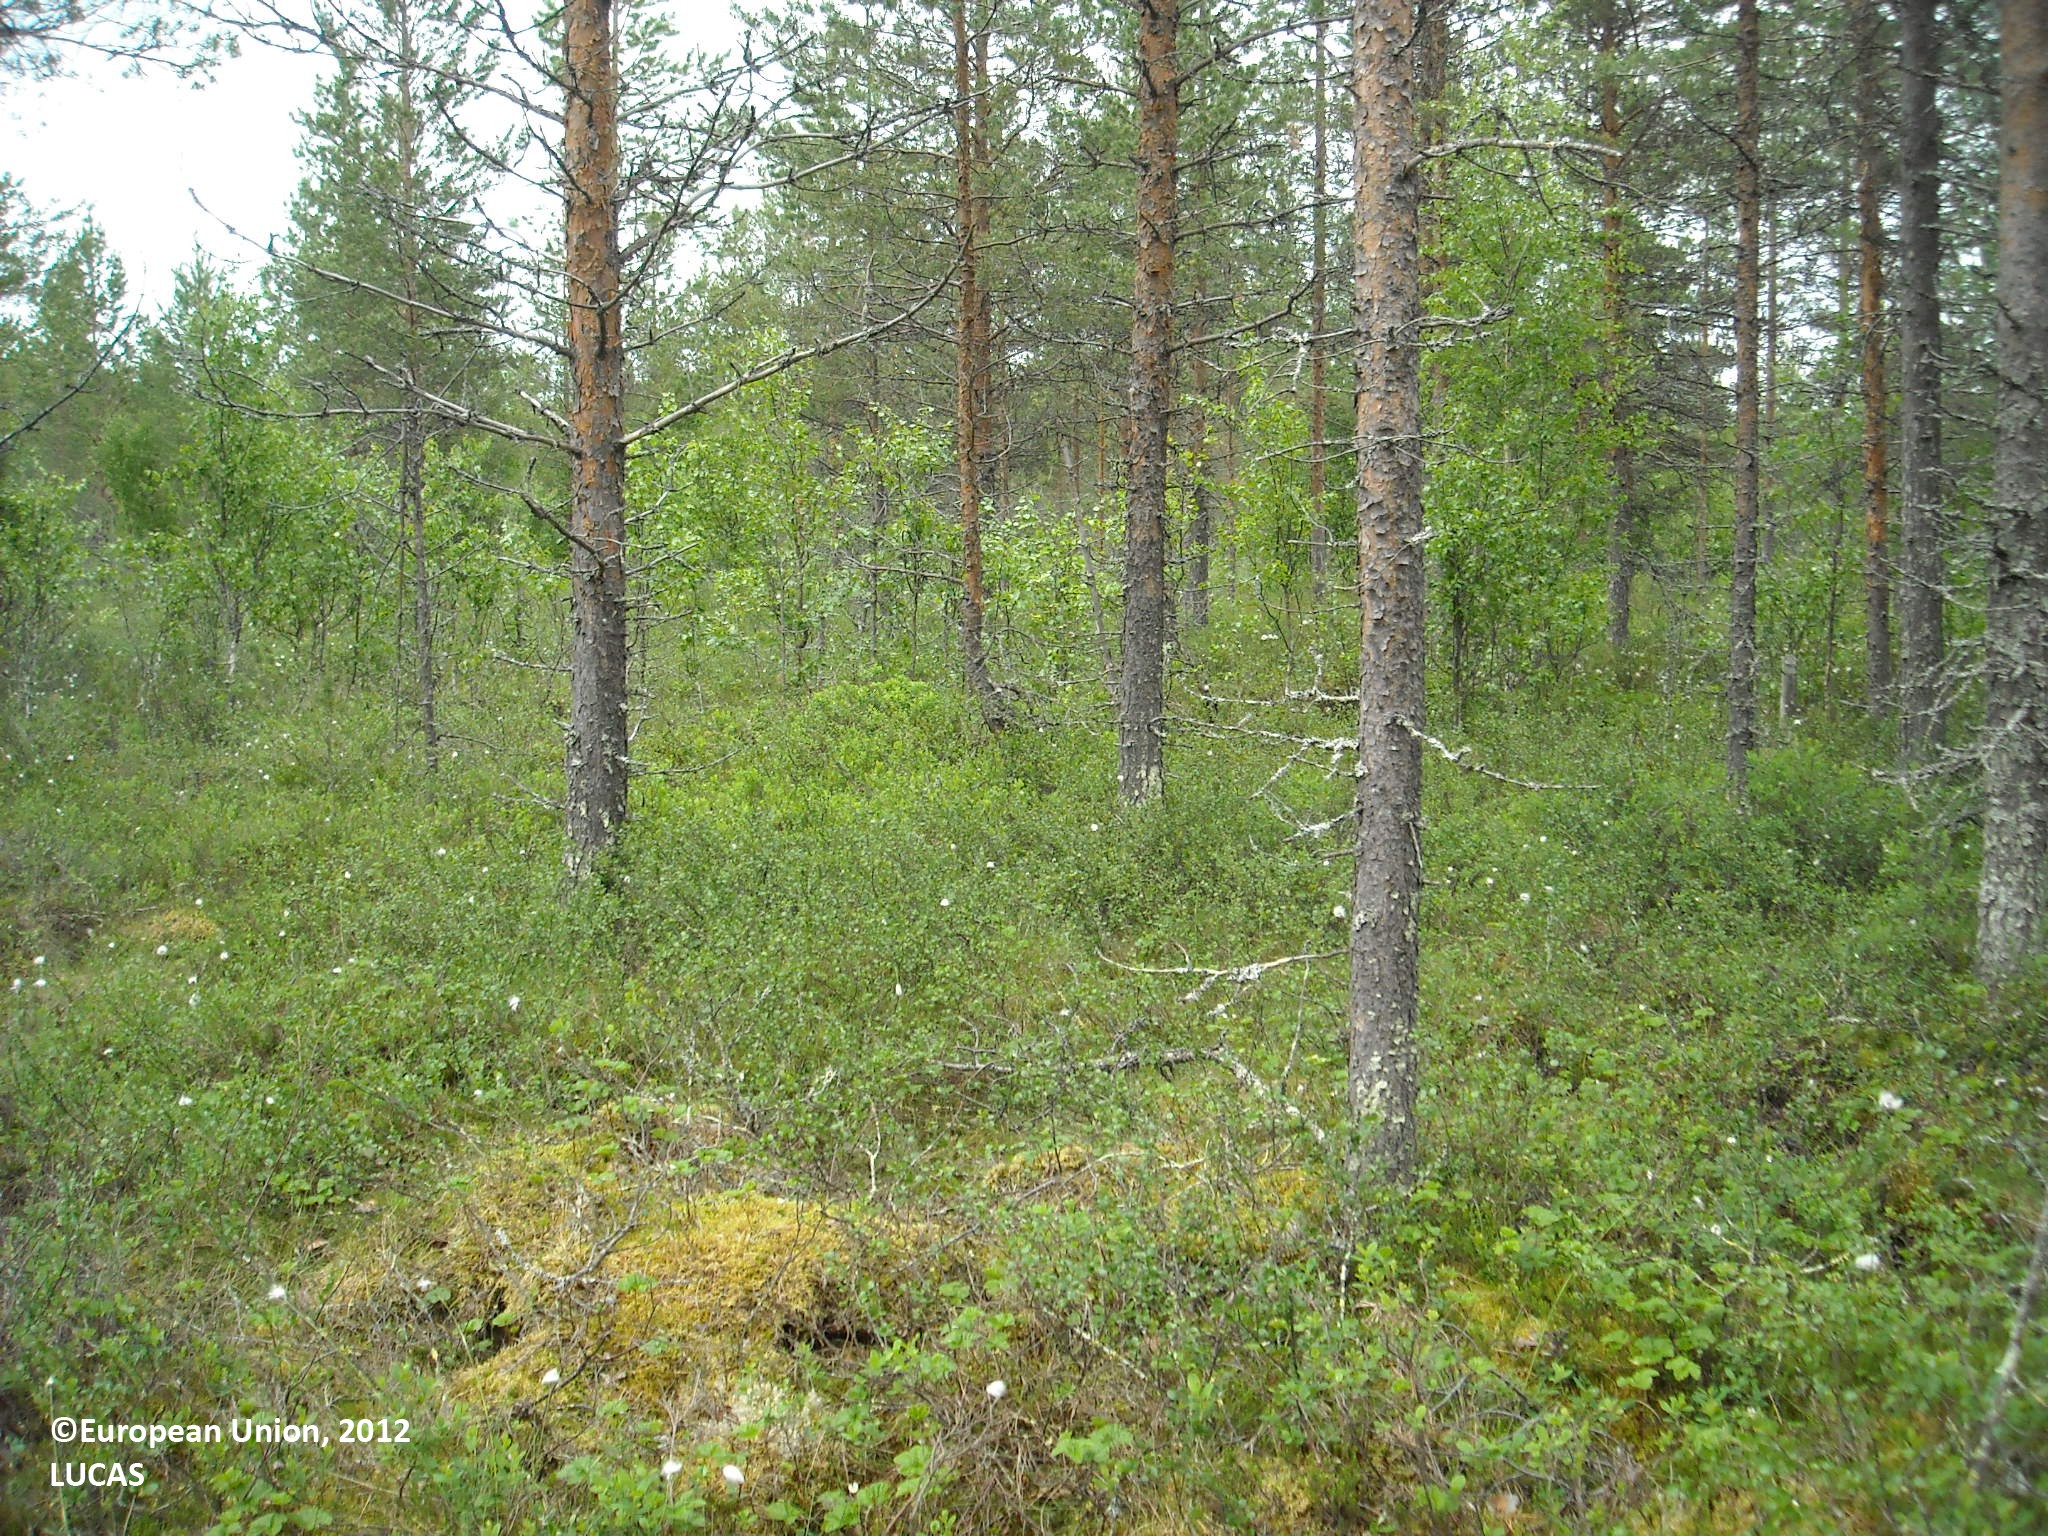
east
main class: Woodland
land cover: Pine dominated coniferous woodland
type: mire and swamp forests
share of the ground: 50 - 75 %
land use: Forestry
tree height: > 5 m
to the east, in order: Pine dominated coniferous woodland; Ditches and canals; Pine dominated coniferous woodland; Ditches and canals; Pine dominated coniferous woodland; Ditches and canals; Pine dominated coniferous woodland; Other mixed woodland
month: June
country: FI
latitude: 64.8435
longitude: 27.3594
